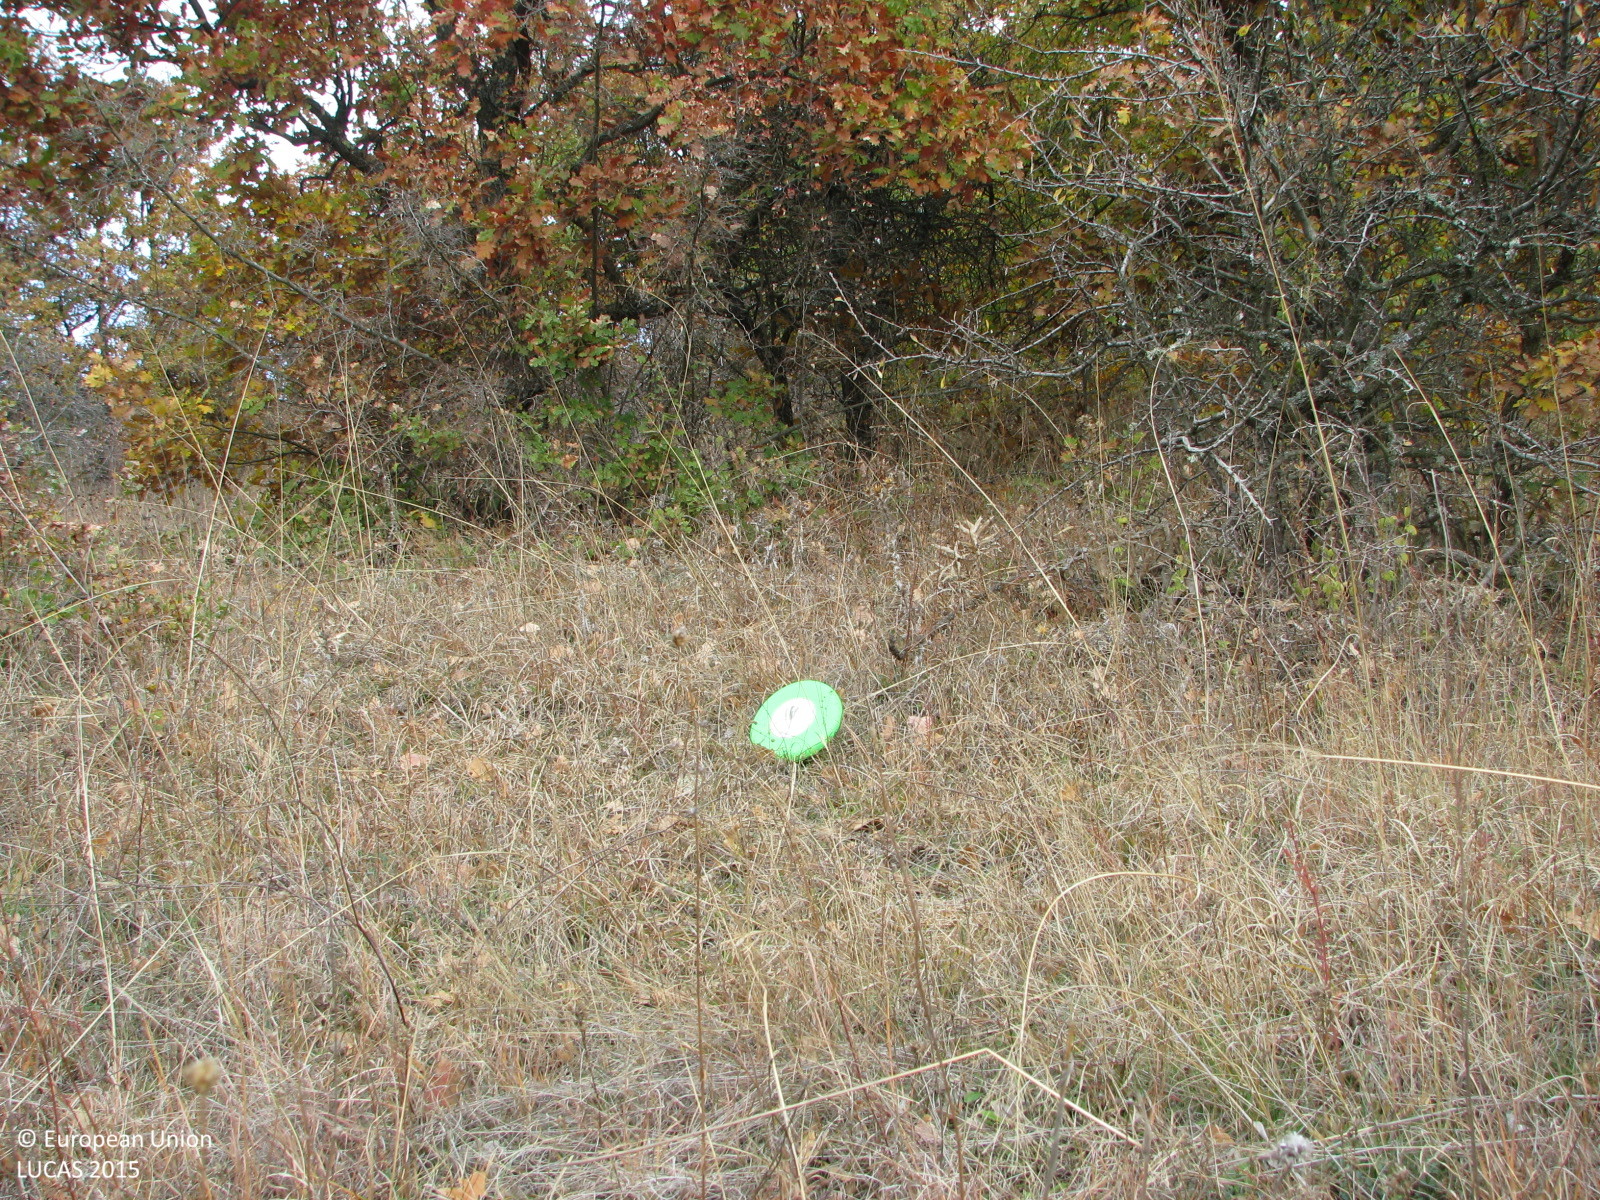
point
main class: Woodland
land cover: Broadleaved woodland
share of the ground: 25 - 50 %
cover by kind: herbaceous plants 50 %, broadleaved forest trees 35 %, shrubs 15 %
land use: Semi-natural and natural areas not in use
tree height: < 5 m
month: November
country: BG
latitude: 41.9046
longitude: 26.3427
